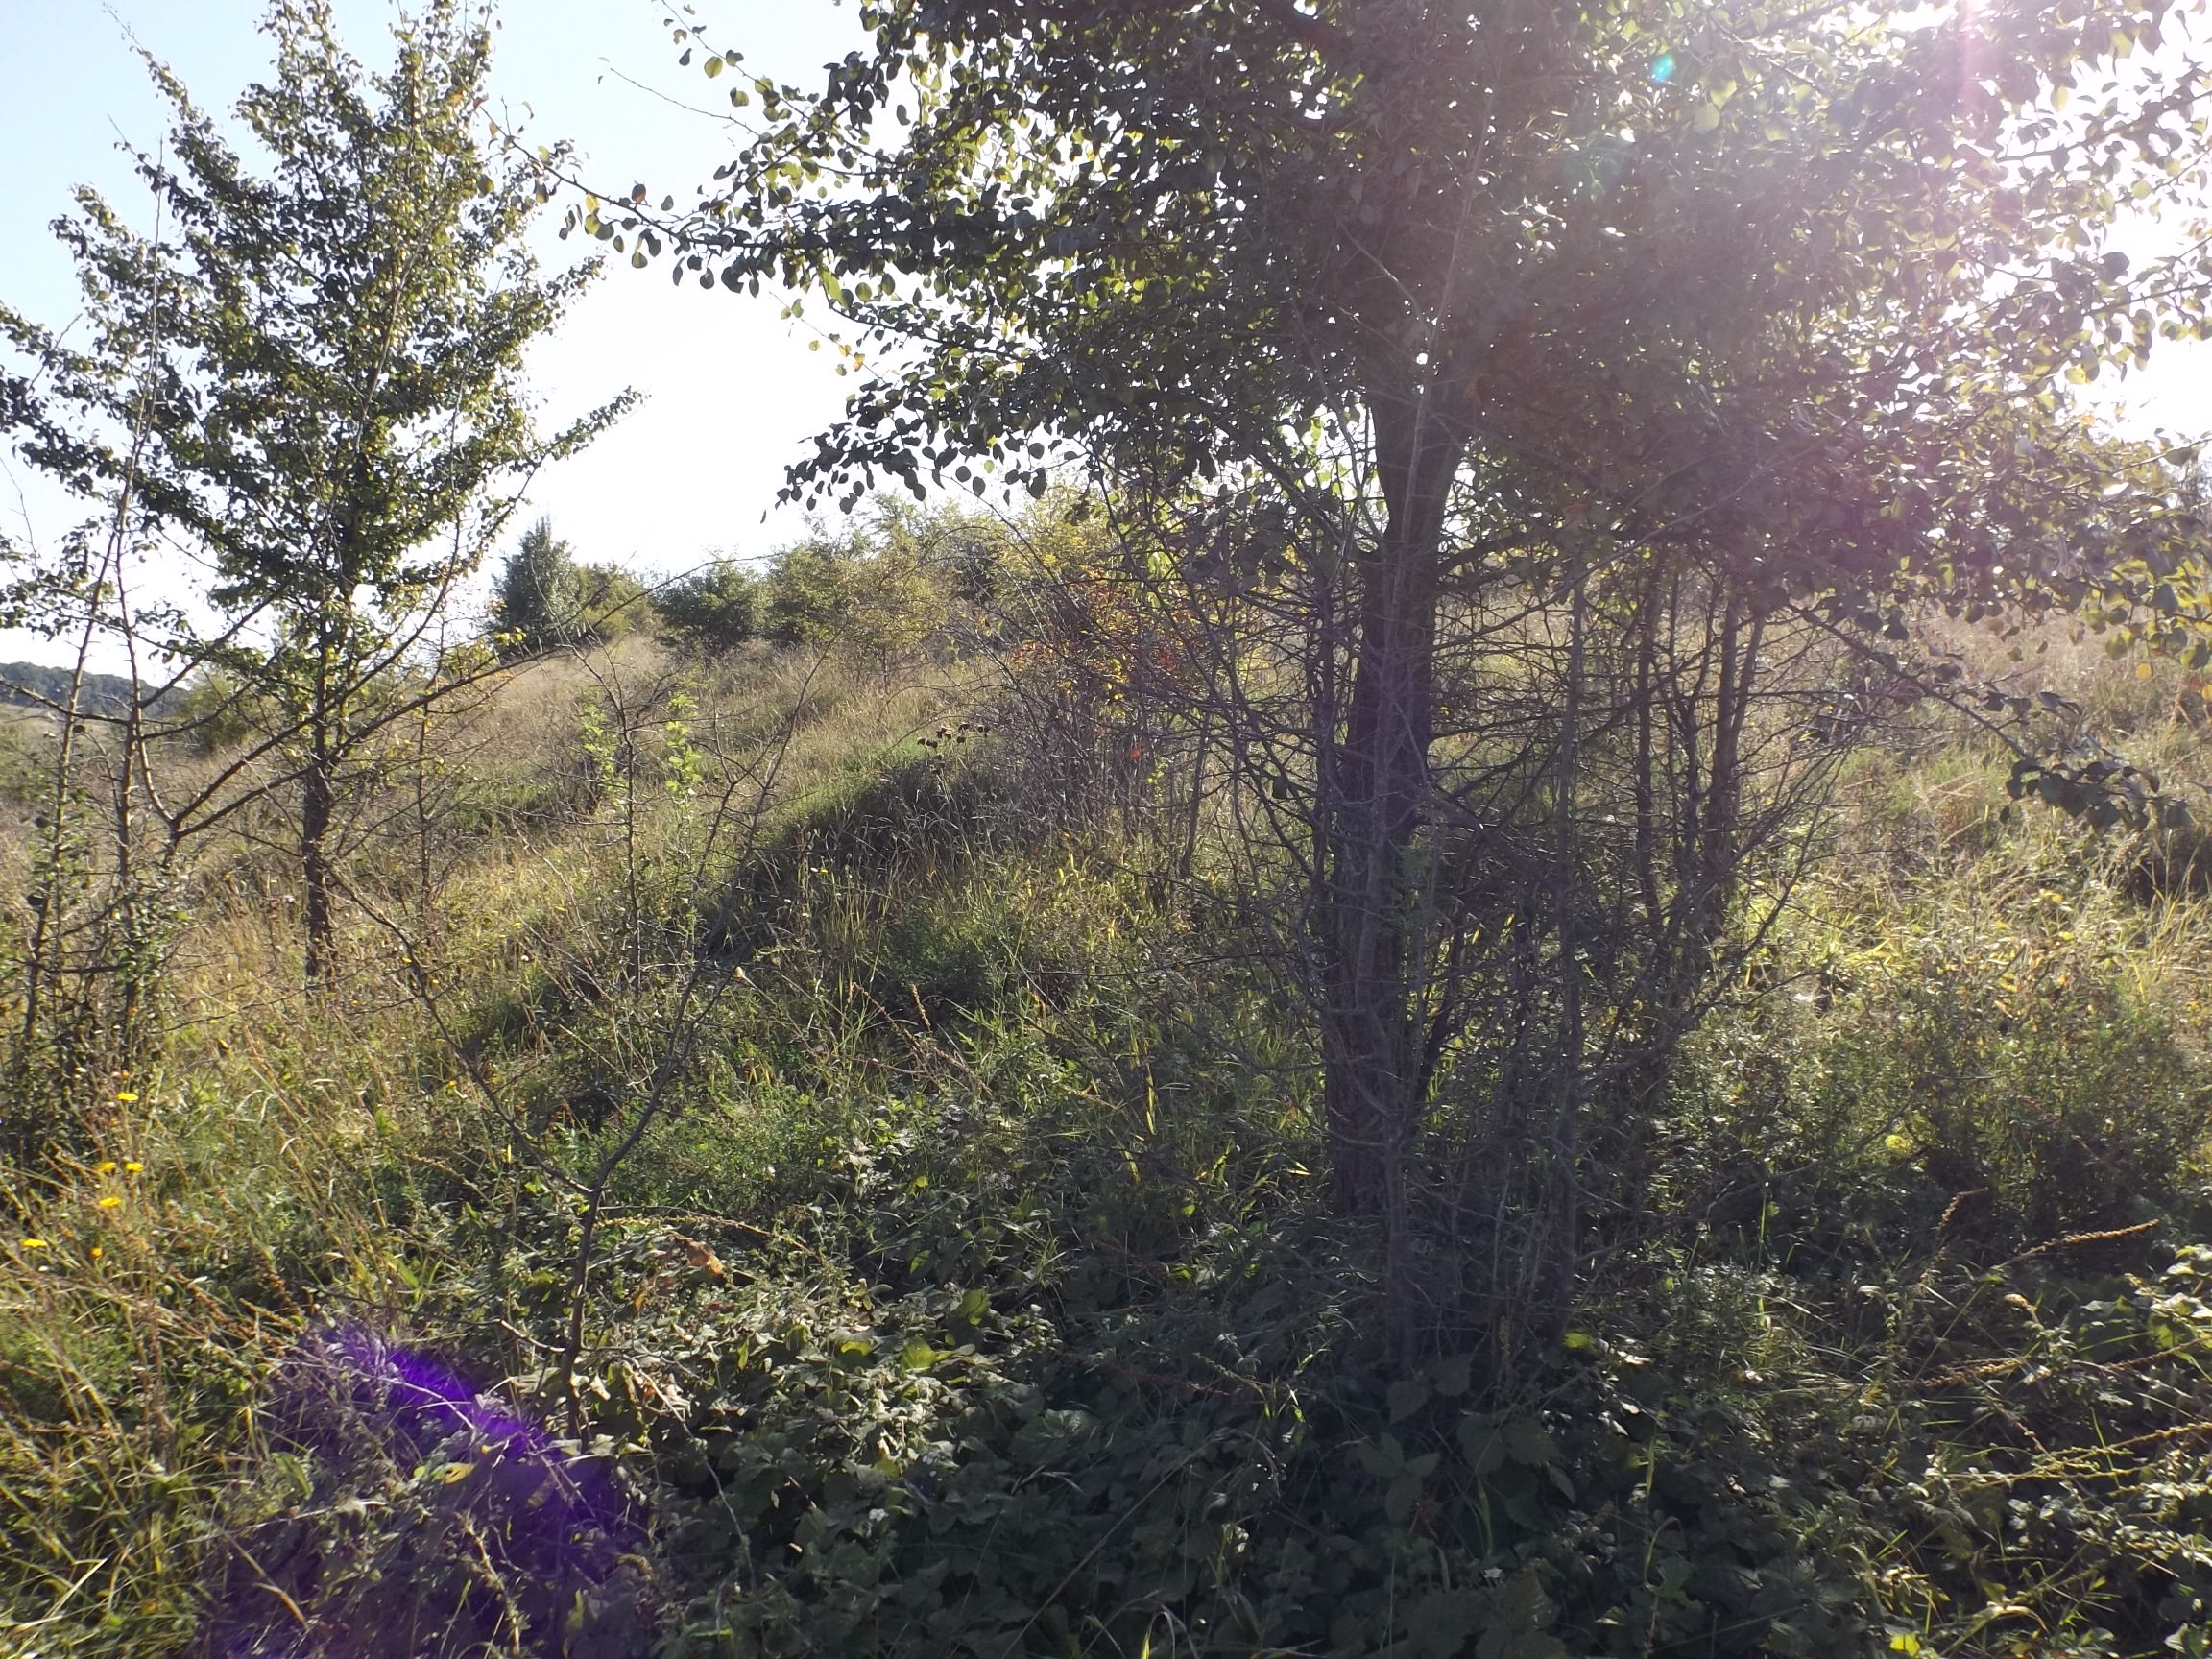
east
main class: Grassland
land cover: Grassland with sparse tree/shrub cover
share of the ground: > 75 %
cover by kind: herbaceous plants 85 %, shrubs 10 %, broadleaved forest trees 5 %
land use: Semi-natural and natural areas not in use
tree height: < 5 m
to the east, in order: Grassland with sparse tree/shrub cover; Maize
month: September
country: BG
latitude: 44.0609
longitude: 26.7583
